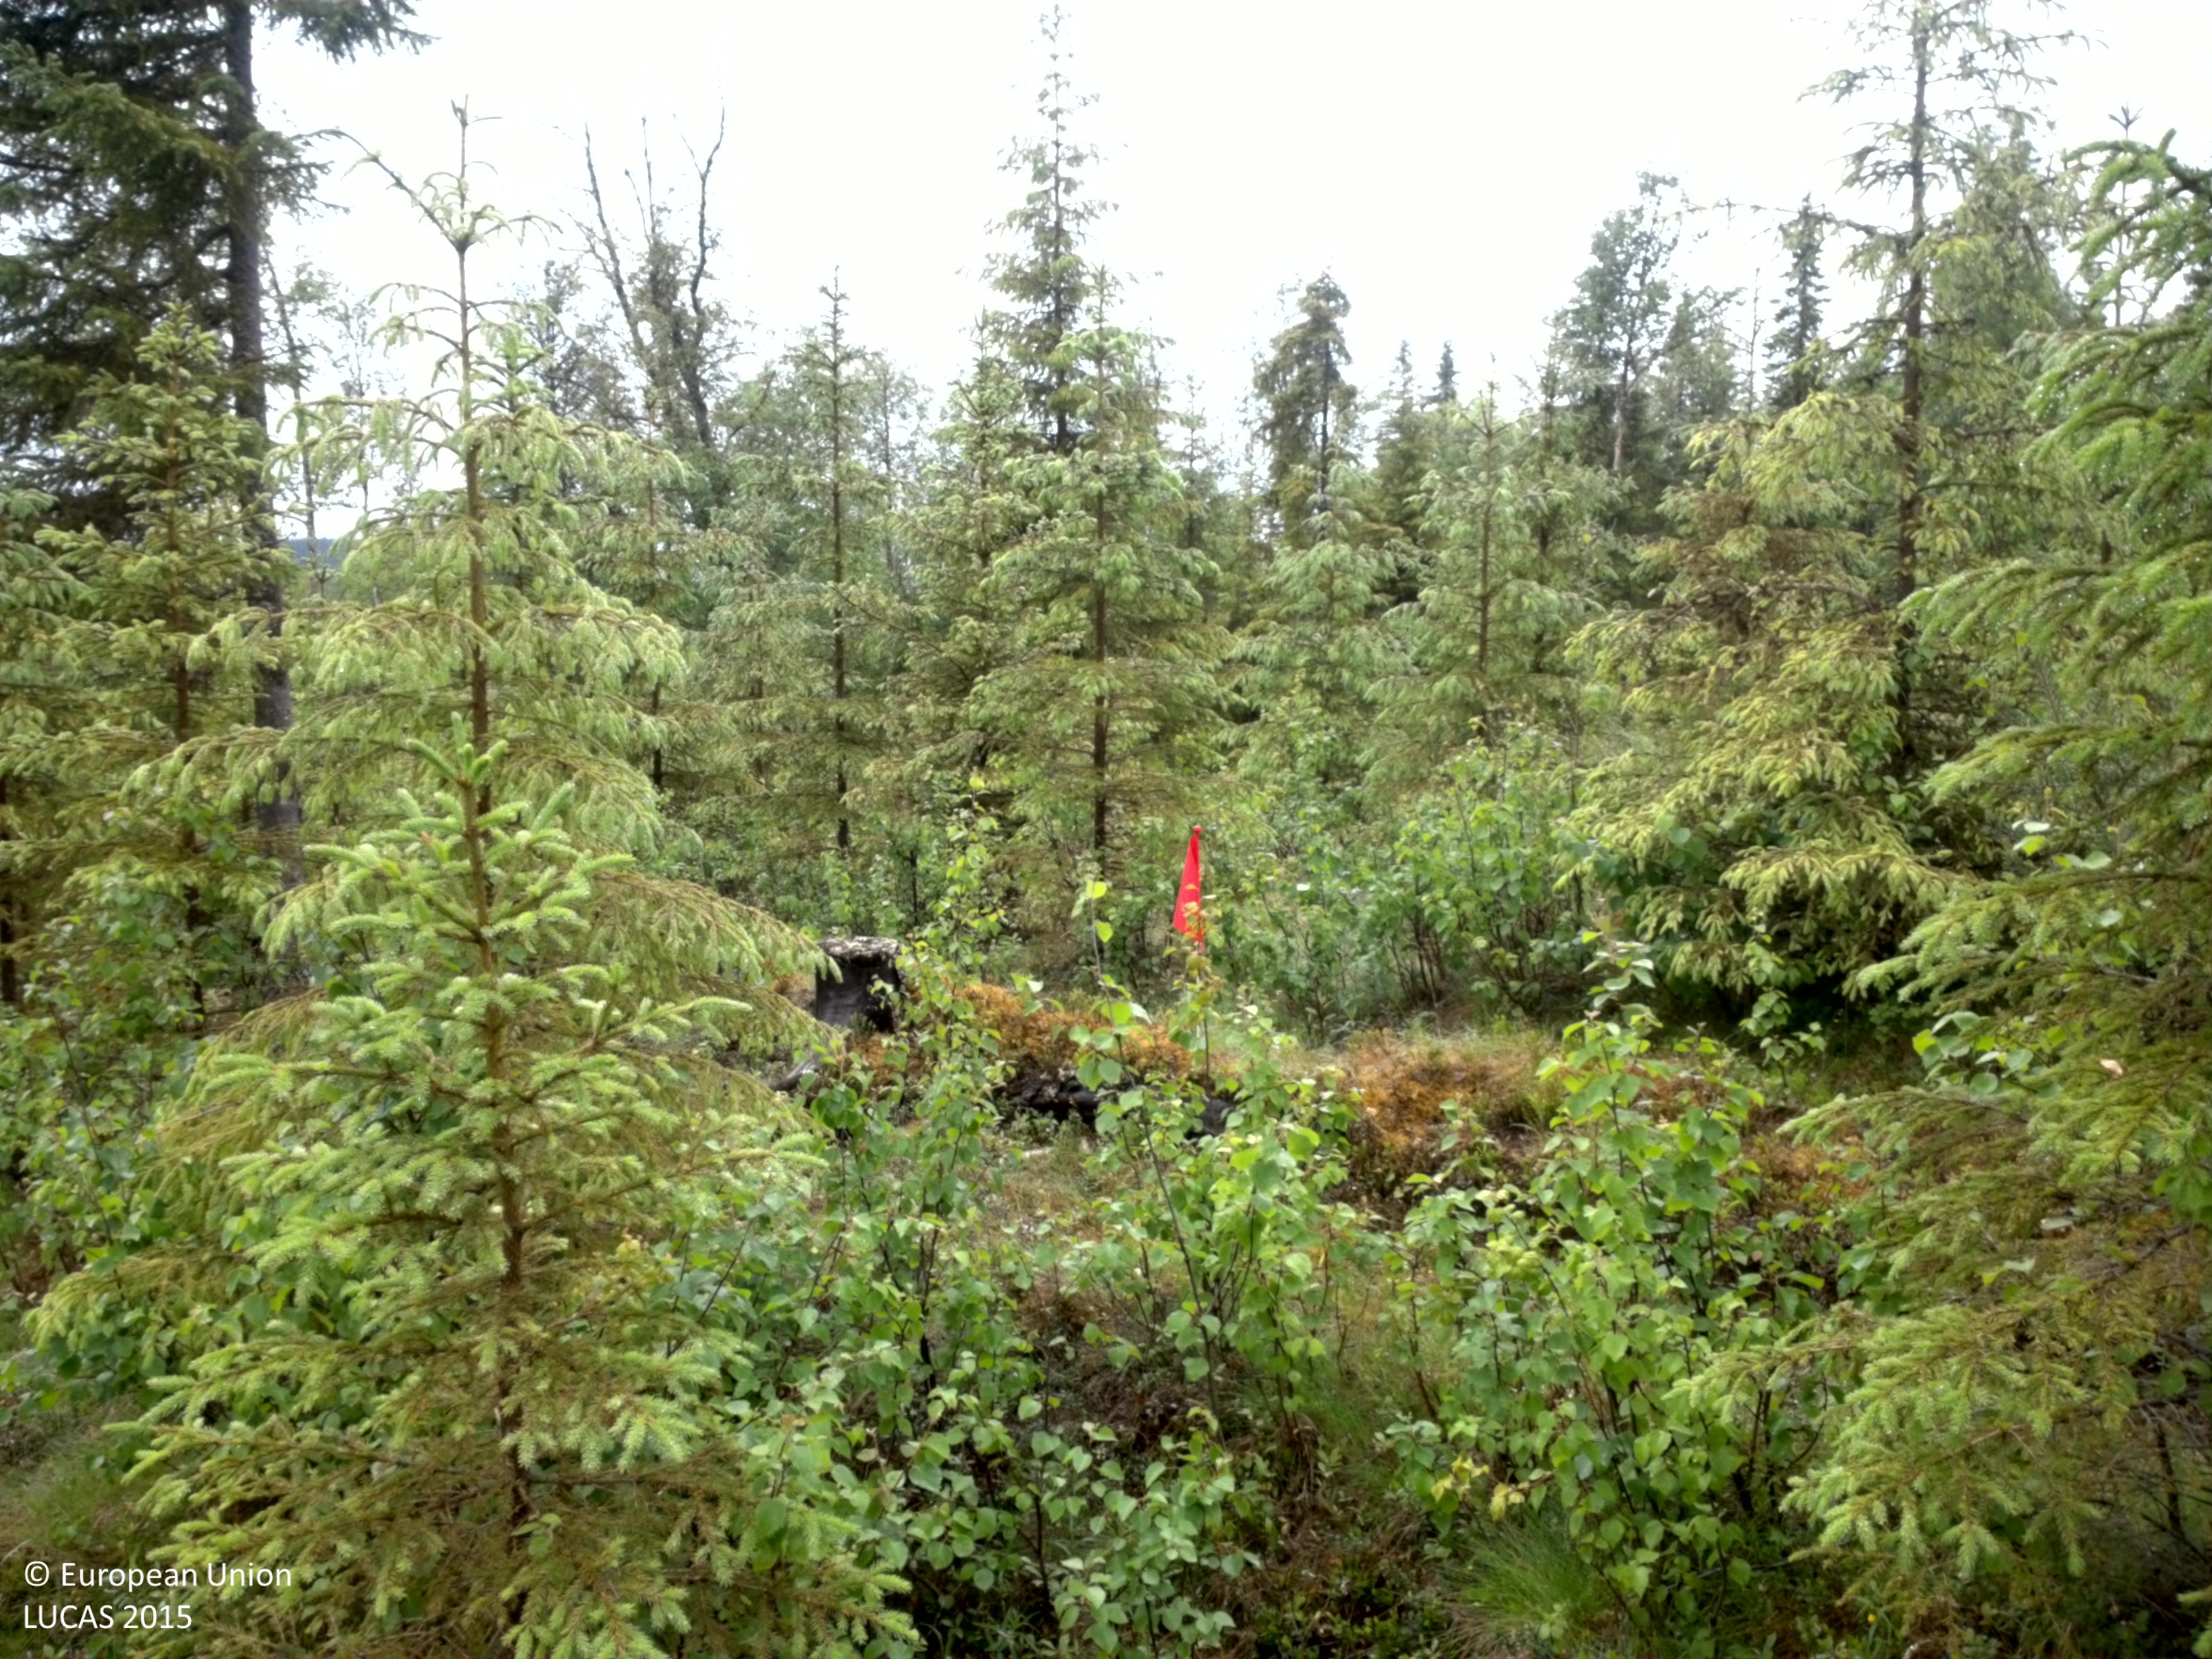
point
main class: Woodland
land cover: Spruce dominated mixed woodland
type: boreal forest
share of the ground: 50 - 75 %
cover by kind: coniferous forest trees 45 %, herbaceous plants 20 %, broadleaved forest trees 15 %, shrubs 15 %, lichens and mosses 5 %
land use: Forestry
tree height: > 5 m
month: July
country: SE
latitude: 64.3573
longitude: 18.3985
